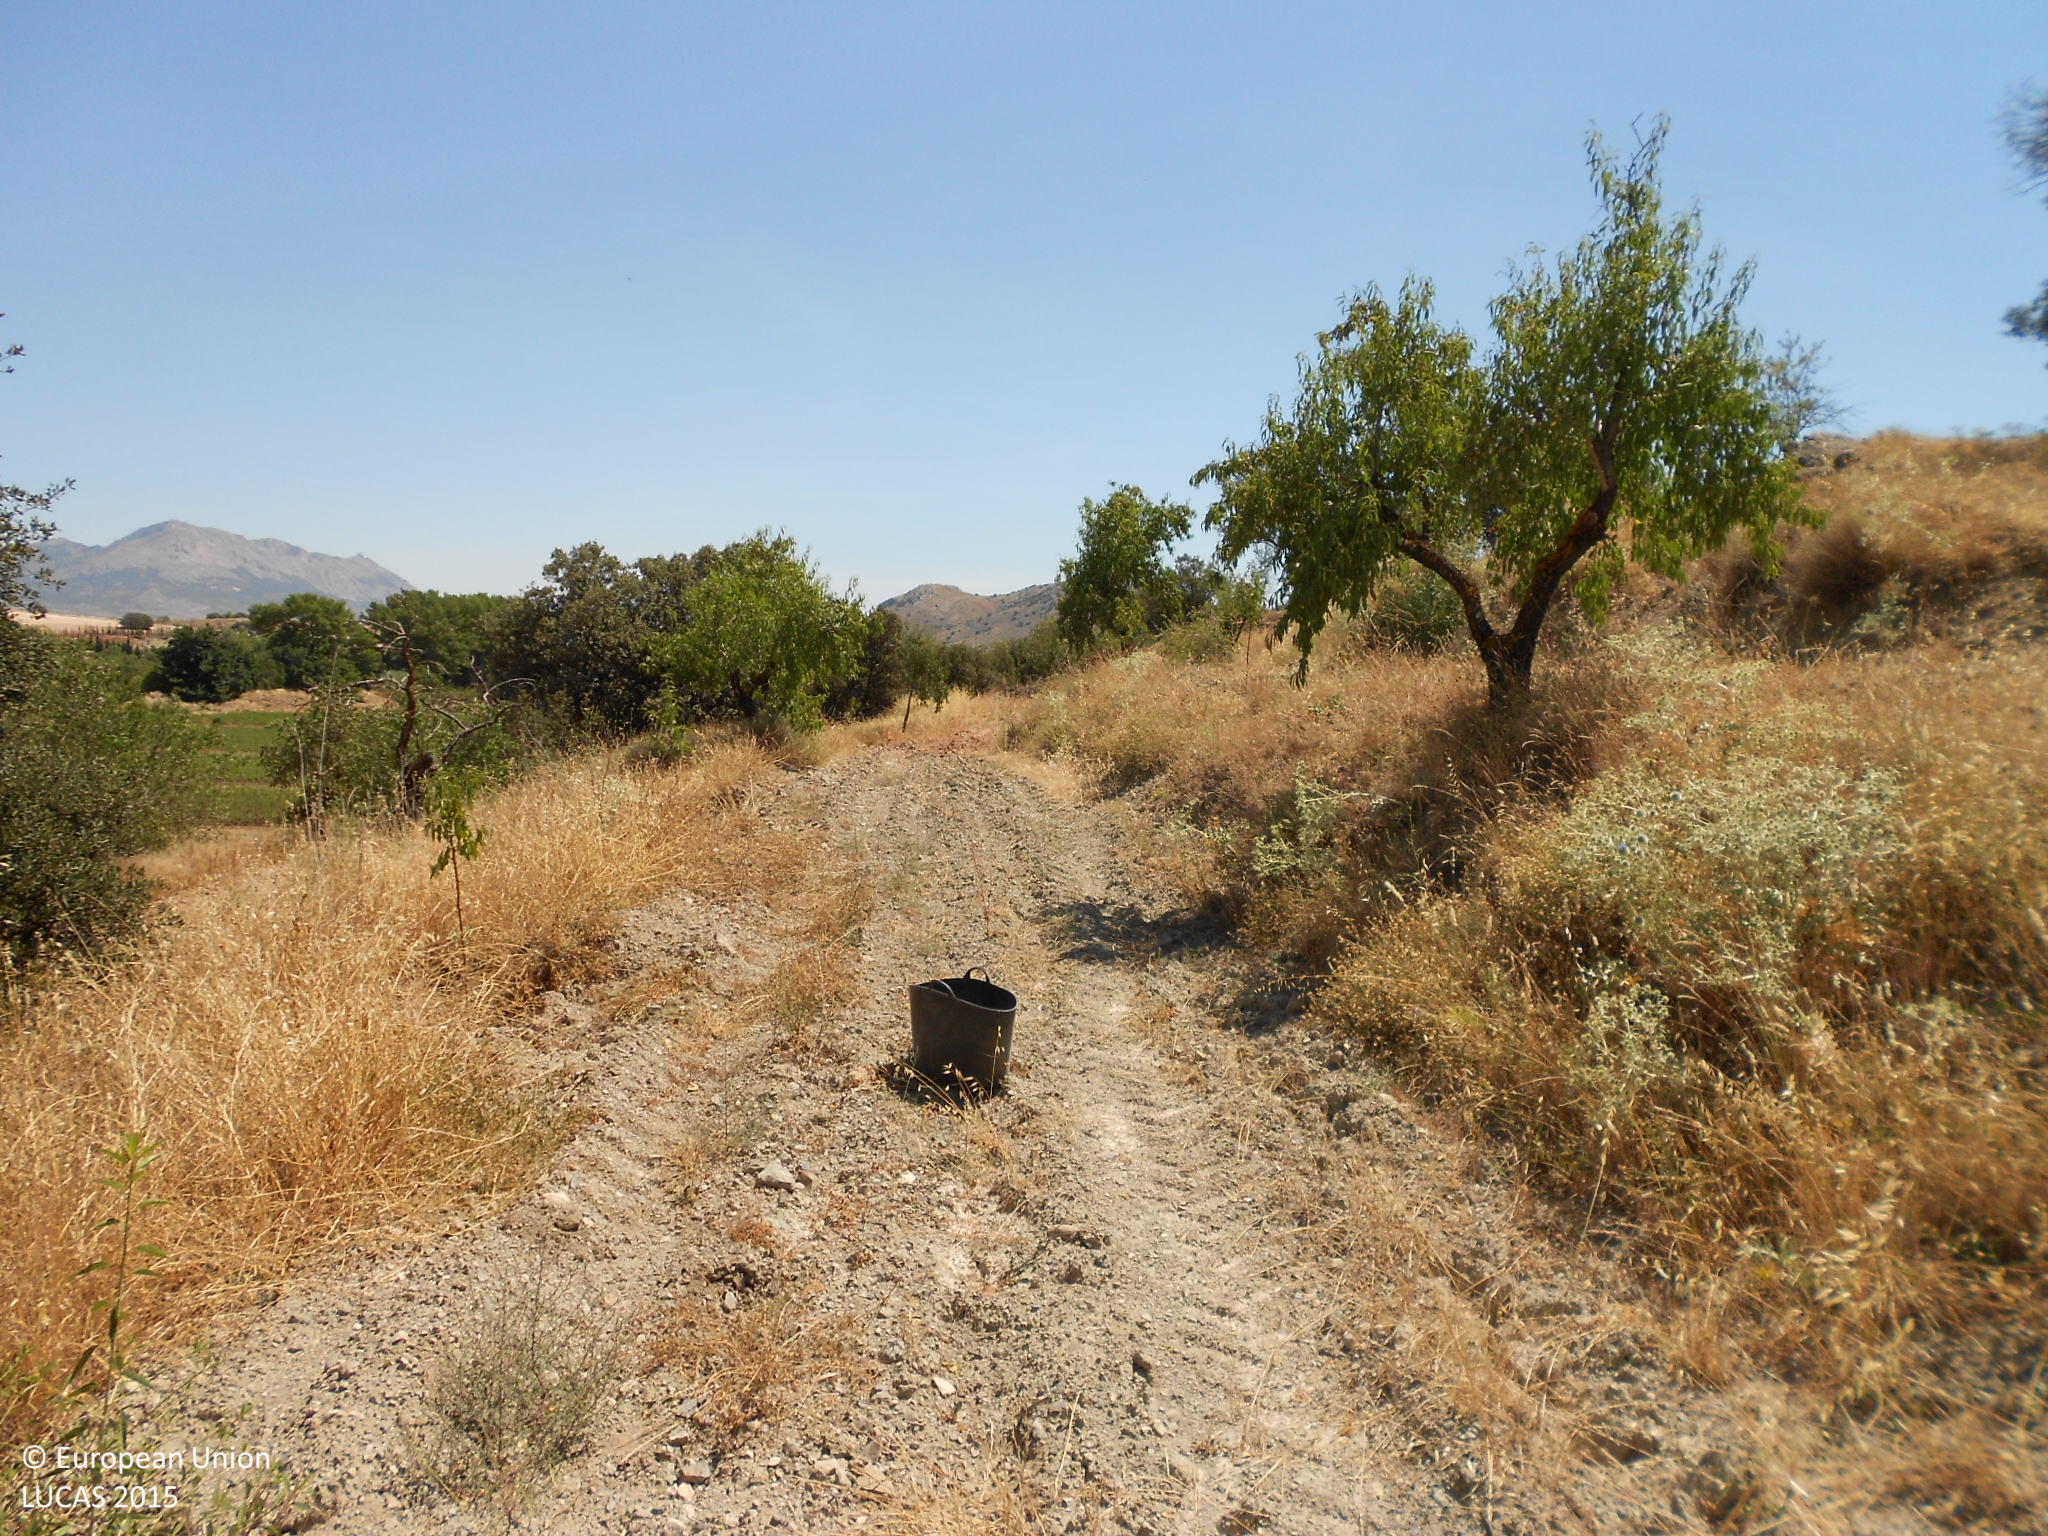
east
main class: Cropland
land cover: Nuts trees
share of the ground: 25 - 50 %
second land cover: Spontaneously vegetated surfaces
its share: 10 - 25 %
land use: Agriculture (excluding fallow land and kitchen gardens)
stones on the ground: > 50 %
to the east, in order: Nuts trees; Spontaneously vegetated surfaces; Groves; Nuts trees; Shrubland with sparse tree cover; Tracks; Shrubland with sparse tree cover; Artificial constructions in urban areas; Shrubland without tree cover; Nuts trees
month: July
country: ES
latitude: 37.5964
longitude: -2.2282
